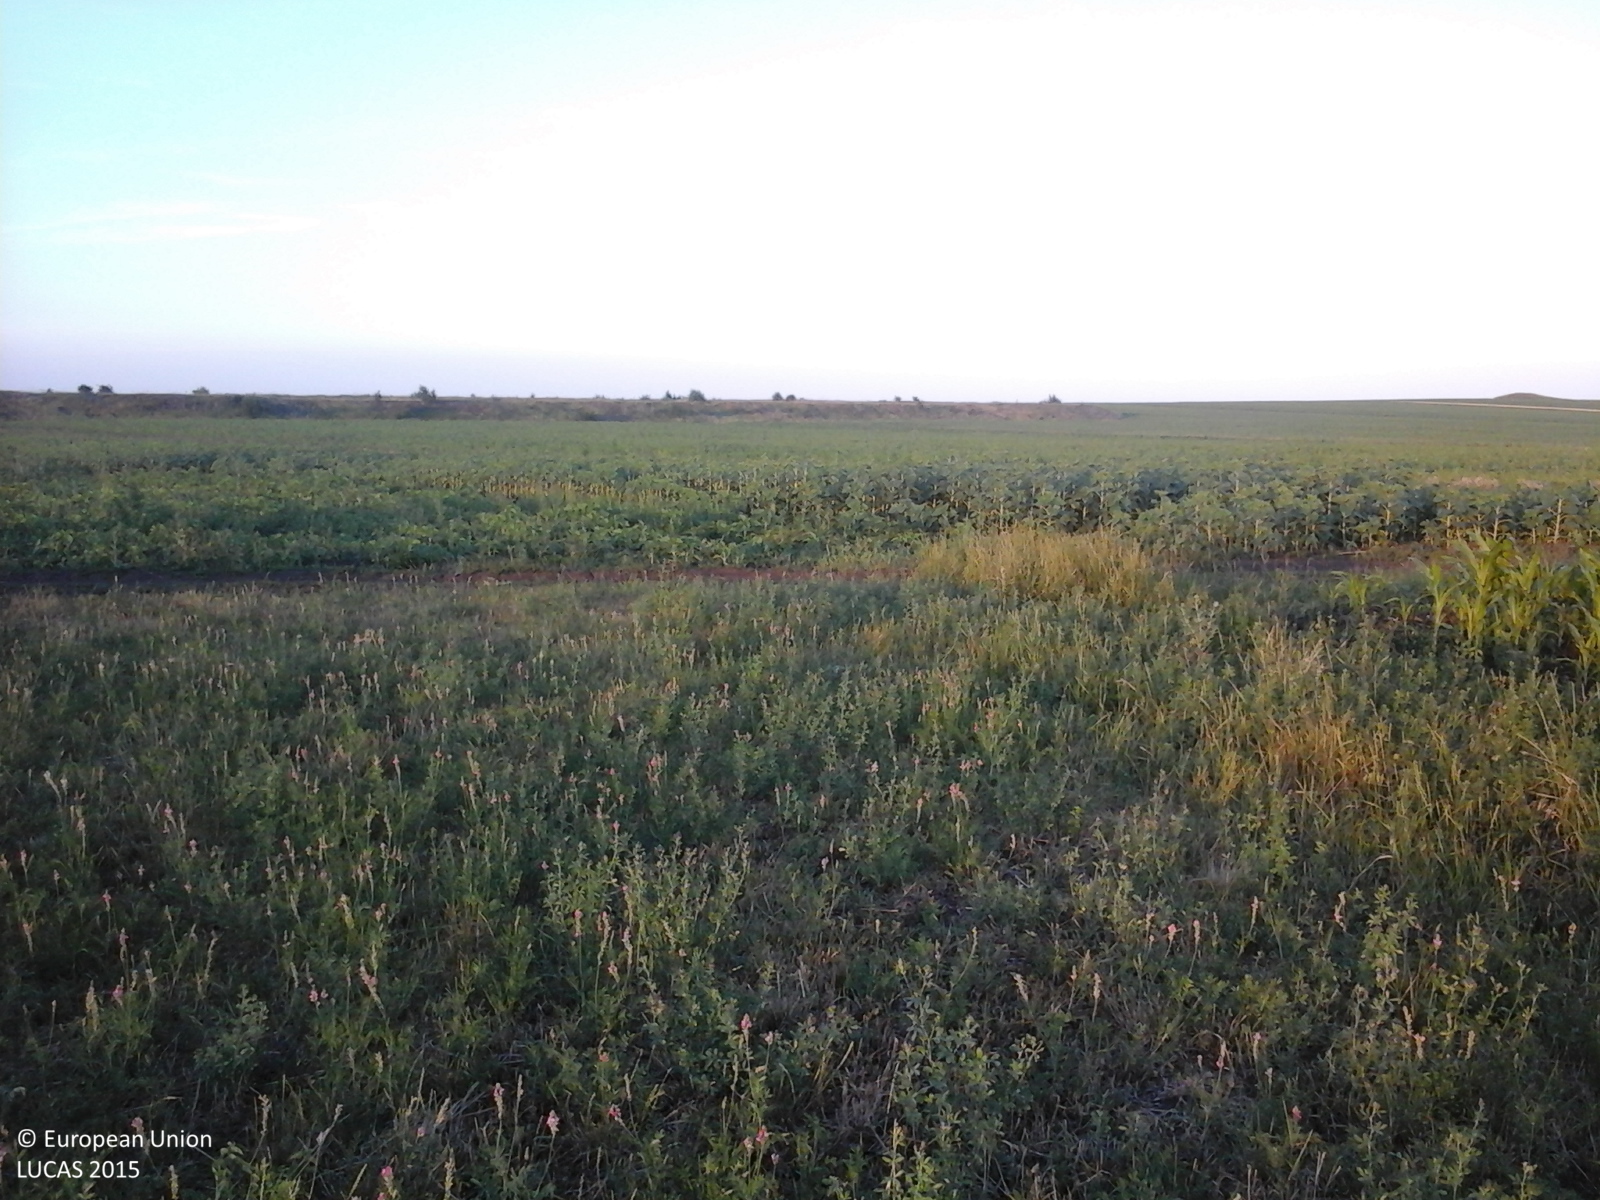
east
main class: Cropland
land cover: Other leguminous and mixtures for fodder
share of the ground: > 75 %
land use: Agriculture (excluding fallow land and kitchen gardens)
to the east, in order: Other leguminous and mixtures for fodder; Grass margins; Tracks; Grass margins; Sunflower; Spontaneously vegetated surfaces; Tracks; Spontaneously vegetated surfaces; Sunflower; Maize; Sunflower; Spontaneously vegetated surfaces
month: June
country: RO
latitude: 47.2758
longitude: 27.1181
